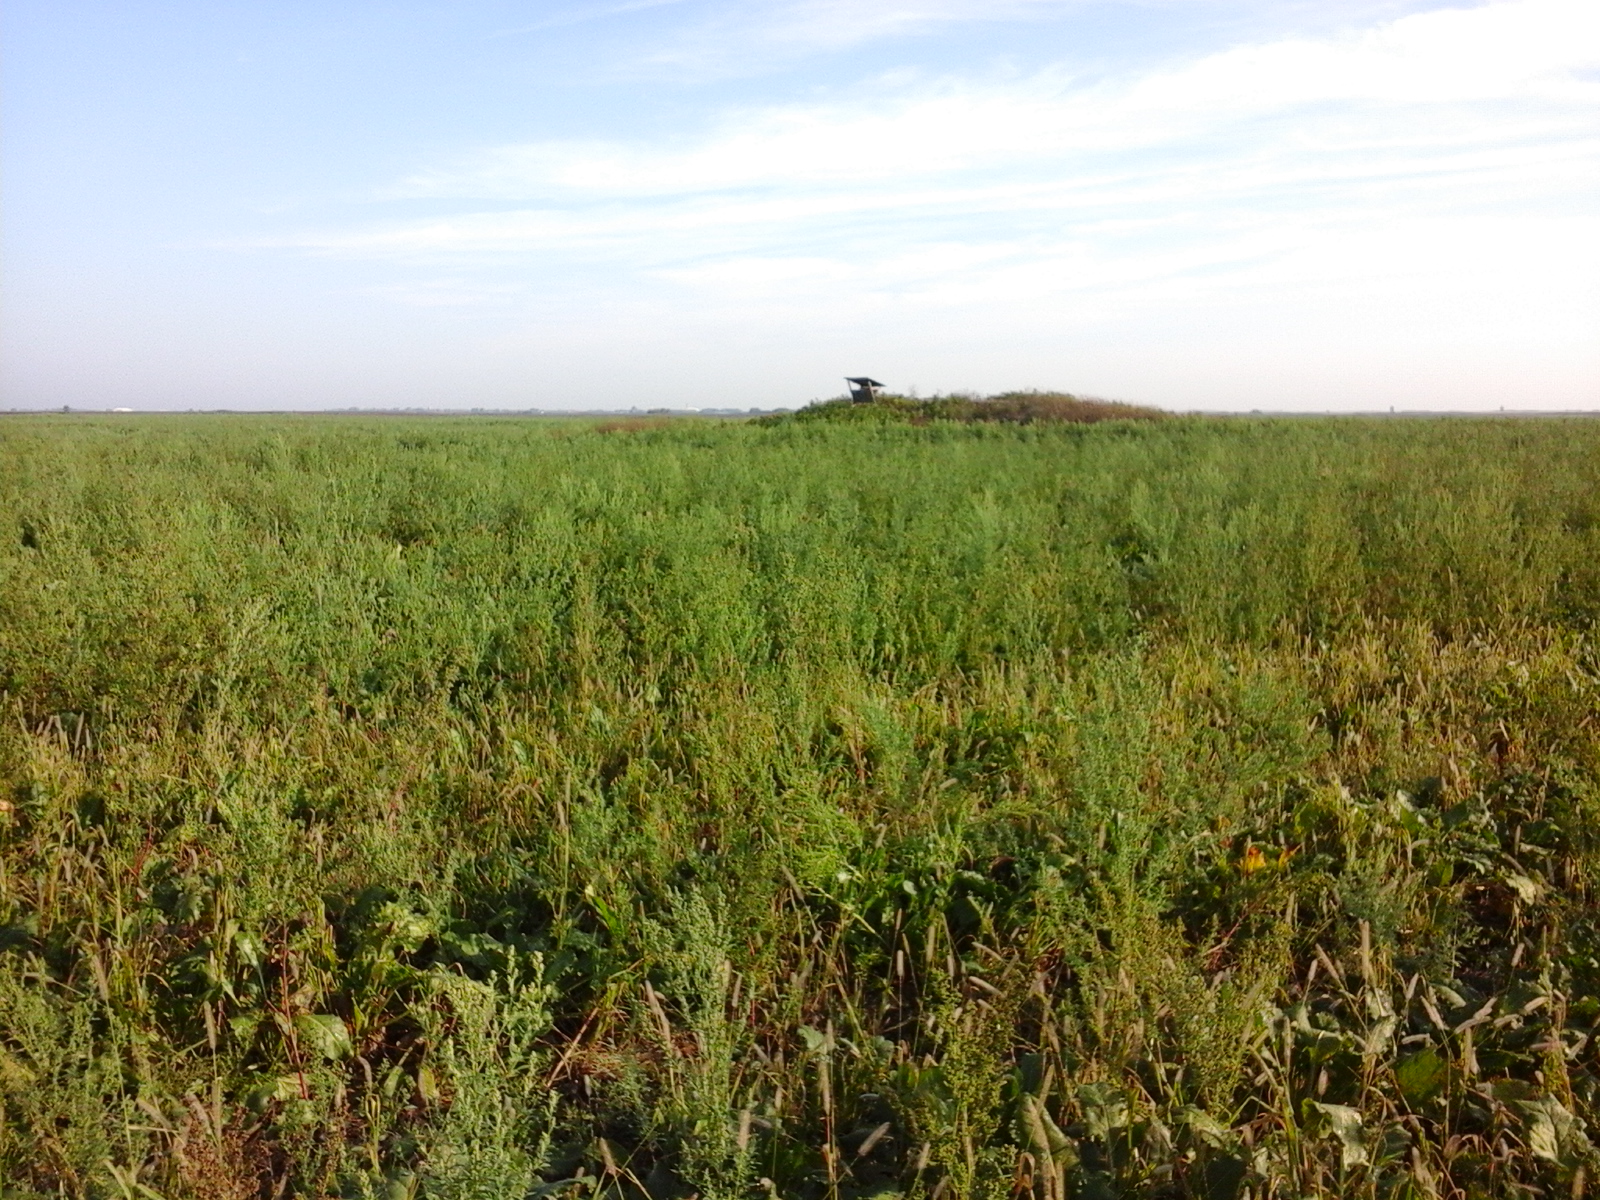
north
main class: Cropland
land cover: Sugar beet
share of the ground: 10 - 25 %
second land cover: Spontaneously vegetated surfaces
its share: > 75 %
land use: Agriculture (excluding fallow land and kitchen gardens)
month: August
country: RO
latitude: 45.7946
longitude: 21.0541
